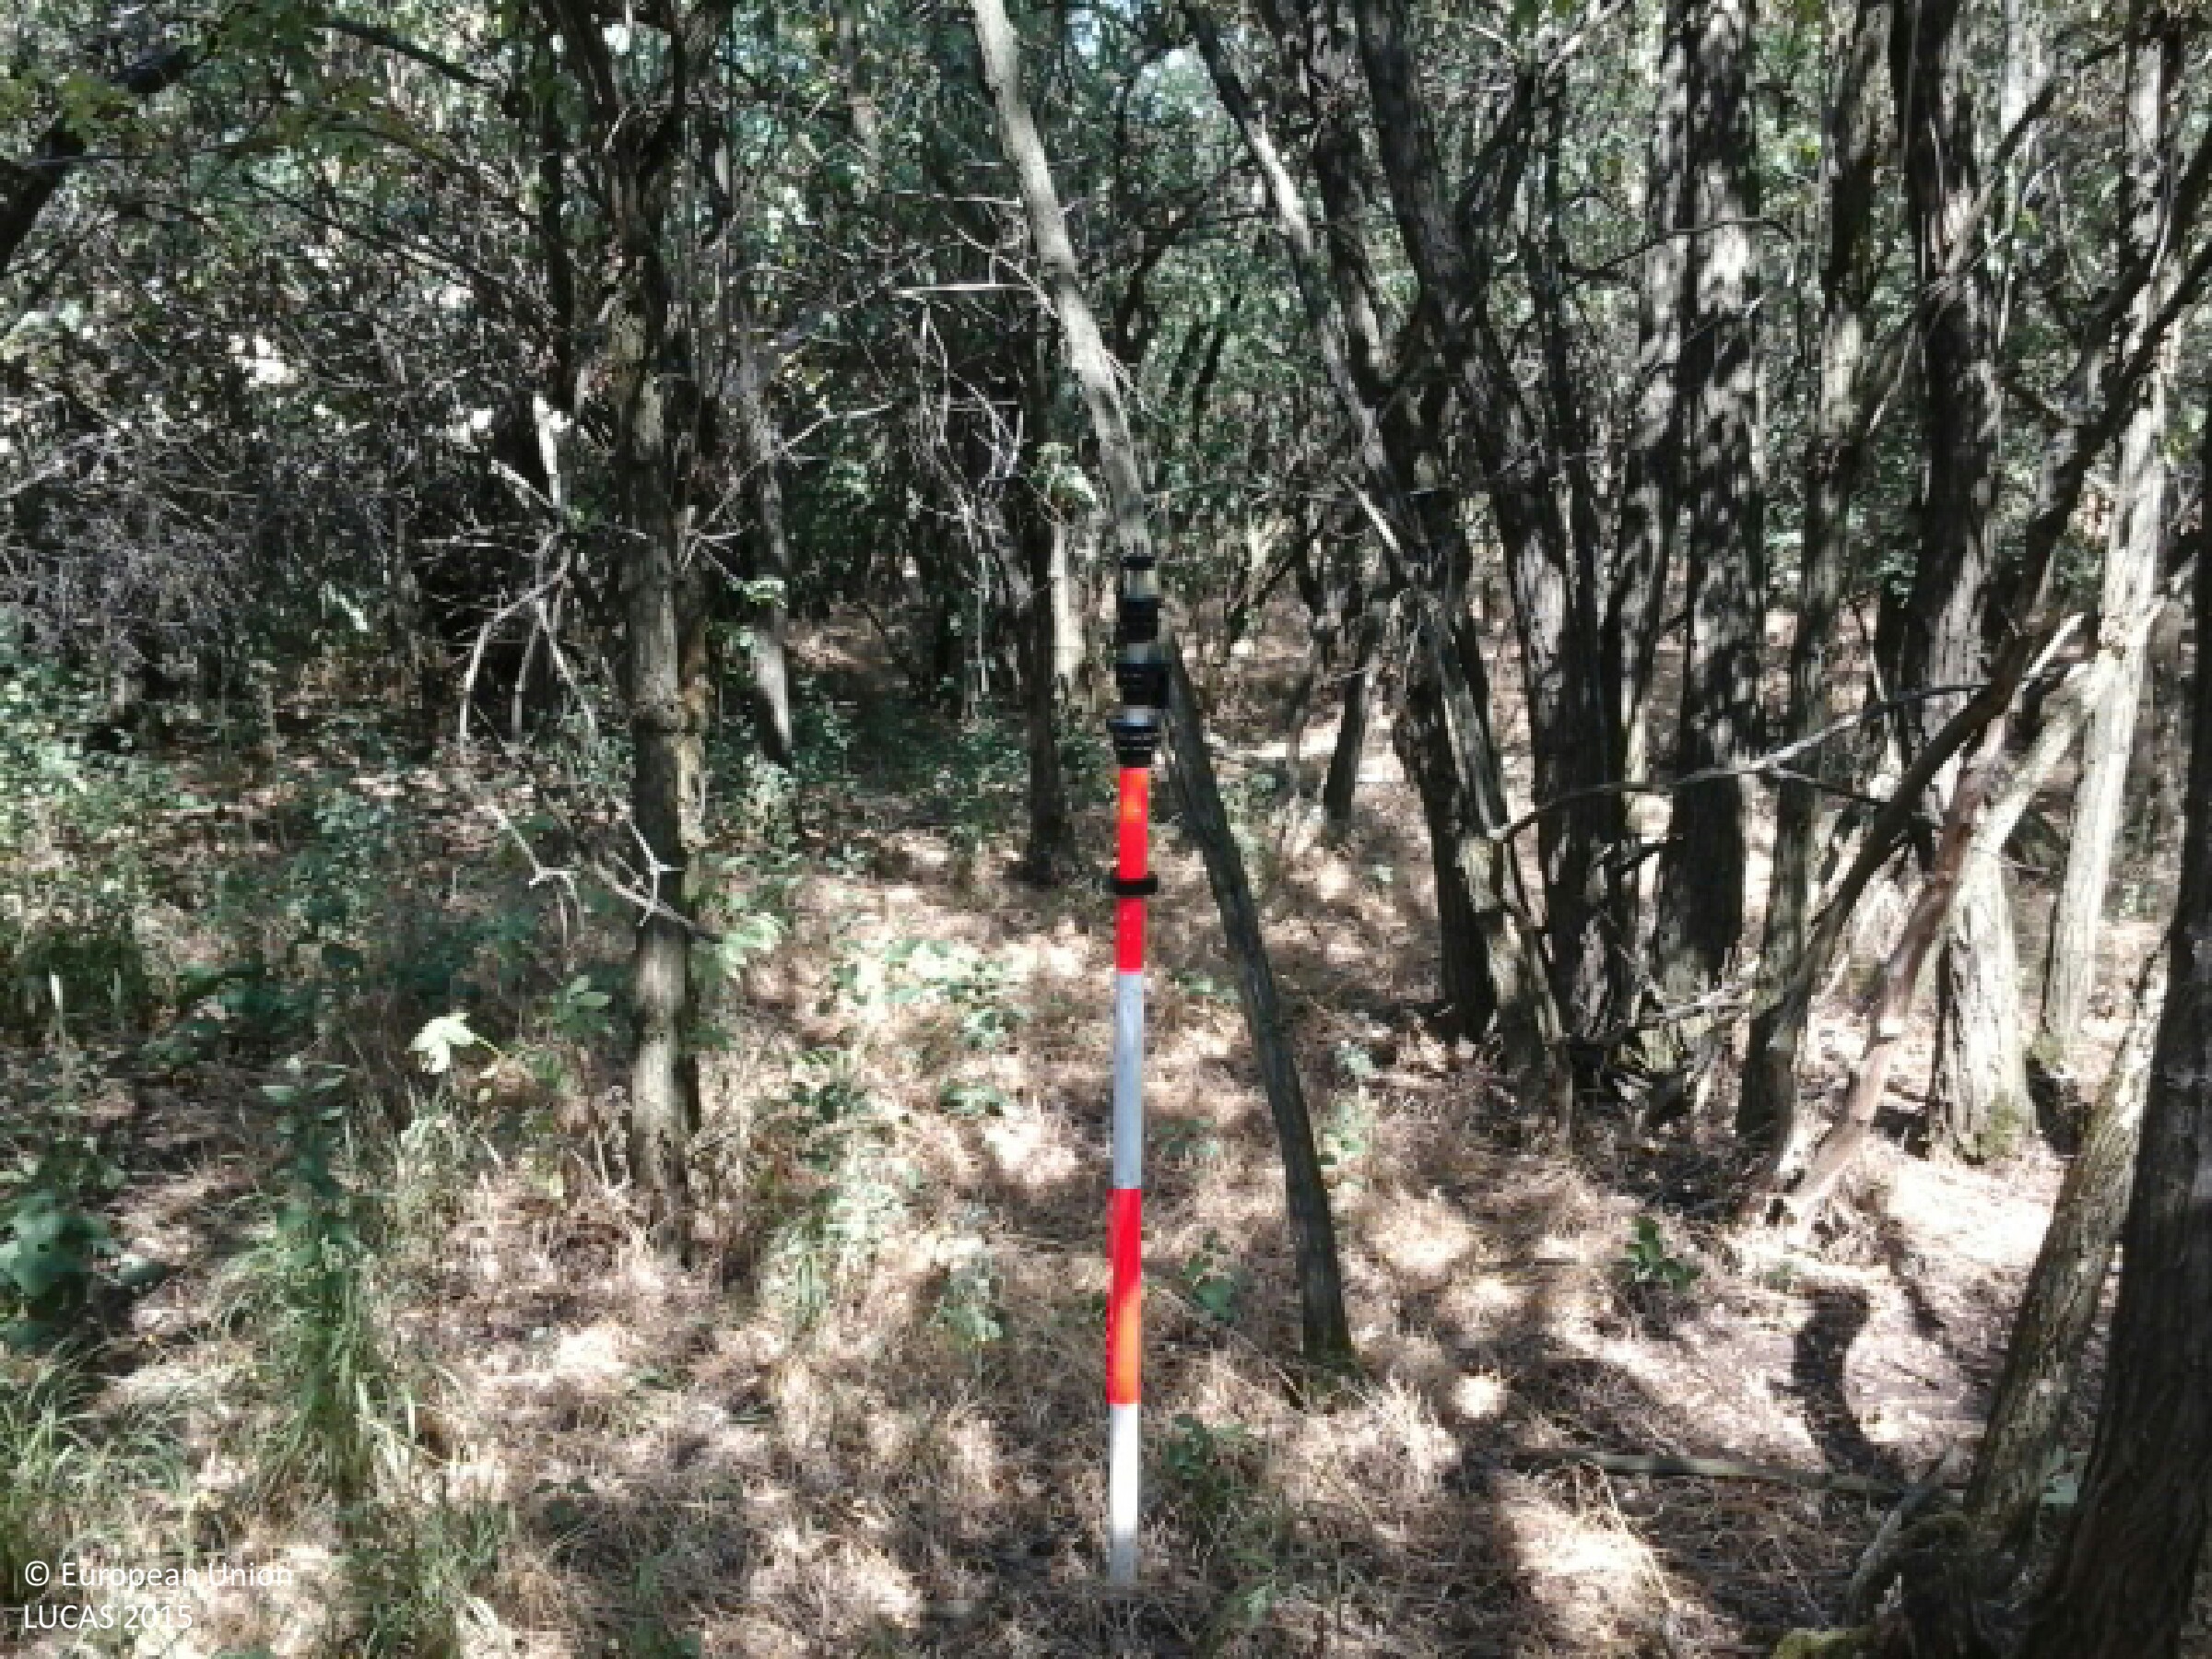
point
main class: Woodland
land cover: Broadleaved woodland
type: mesophytic deciduous forest
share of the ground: > 75 %
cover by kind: broadleaved forest trees 100 %
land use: Forestry
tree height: > 5 m
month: July
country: HU
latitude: 48.1689
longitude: 21.1072
